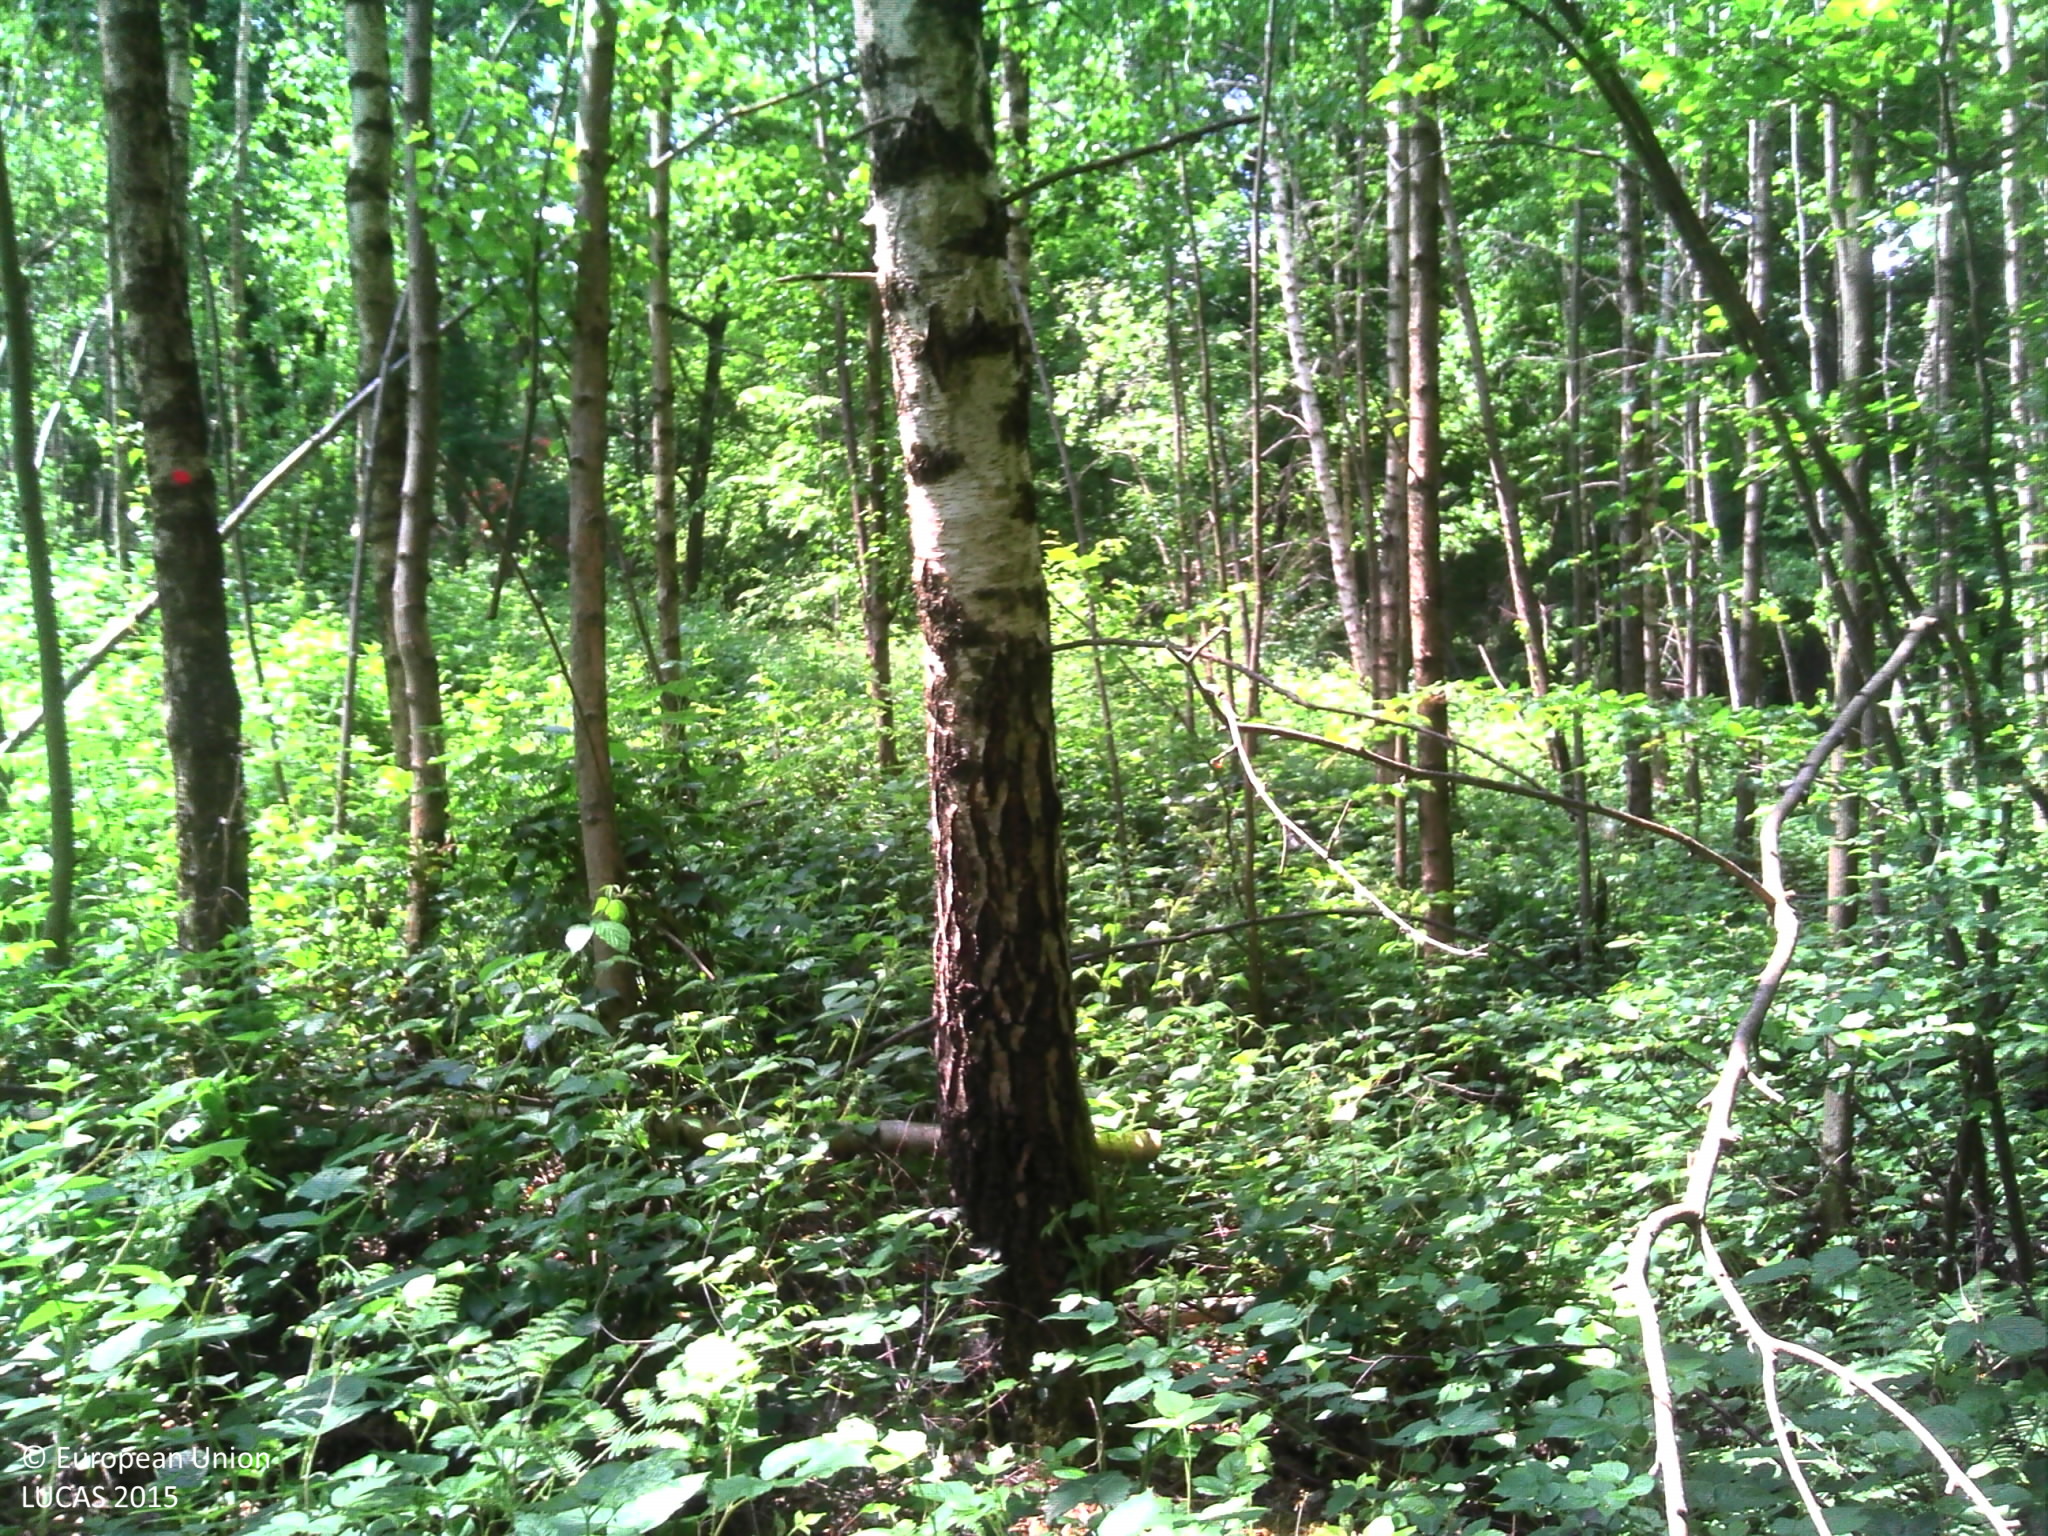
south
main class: Woodland
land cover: Broadleaved woodland
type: acidophilous oak and oak-birch forest
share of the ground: > 75 %
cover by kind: broadleaved forest trees 100 %
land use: Forestry
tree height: > 5 m
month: May
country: BE
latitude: 50.6102
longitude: 4.4987
